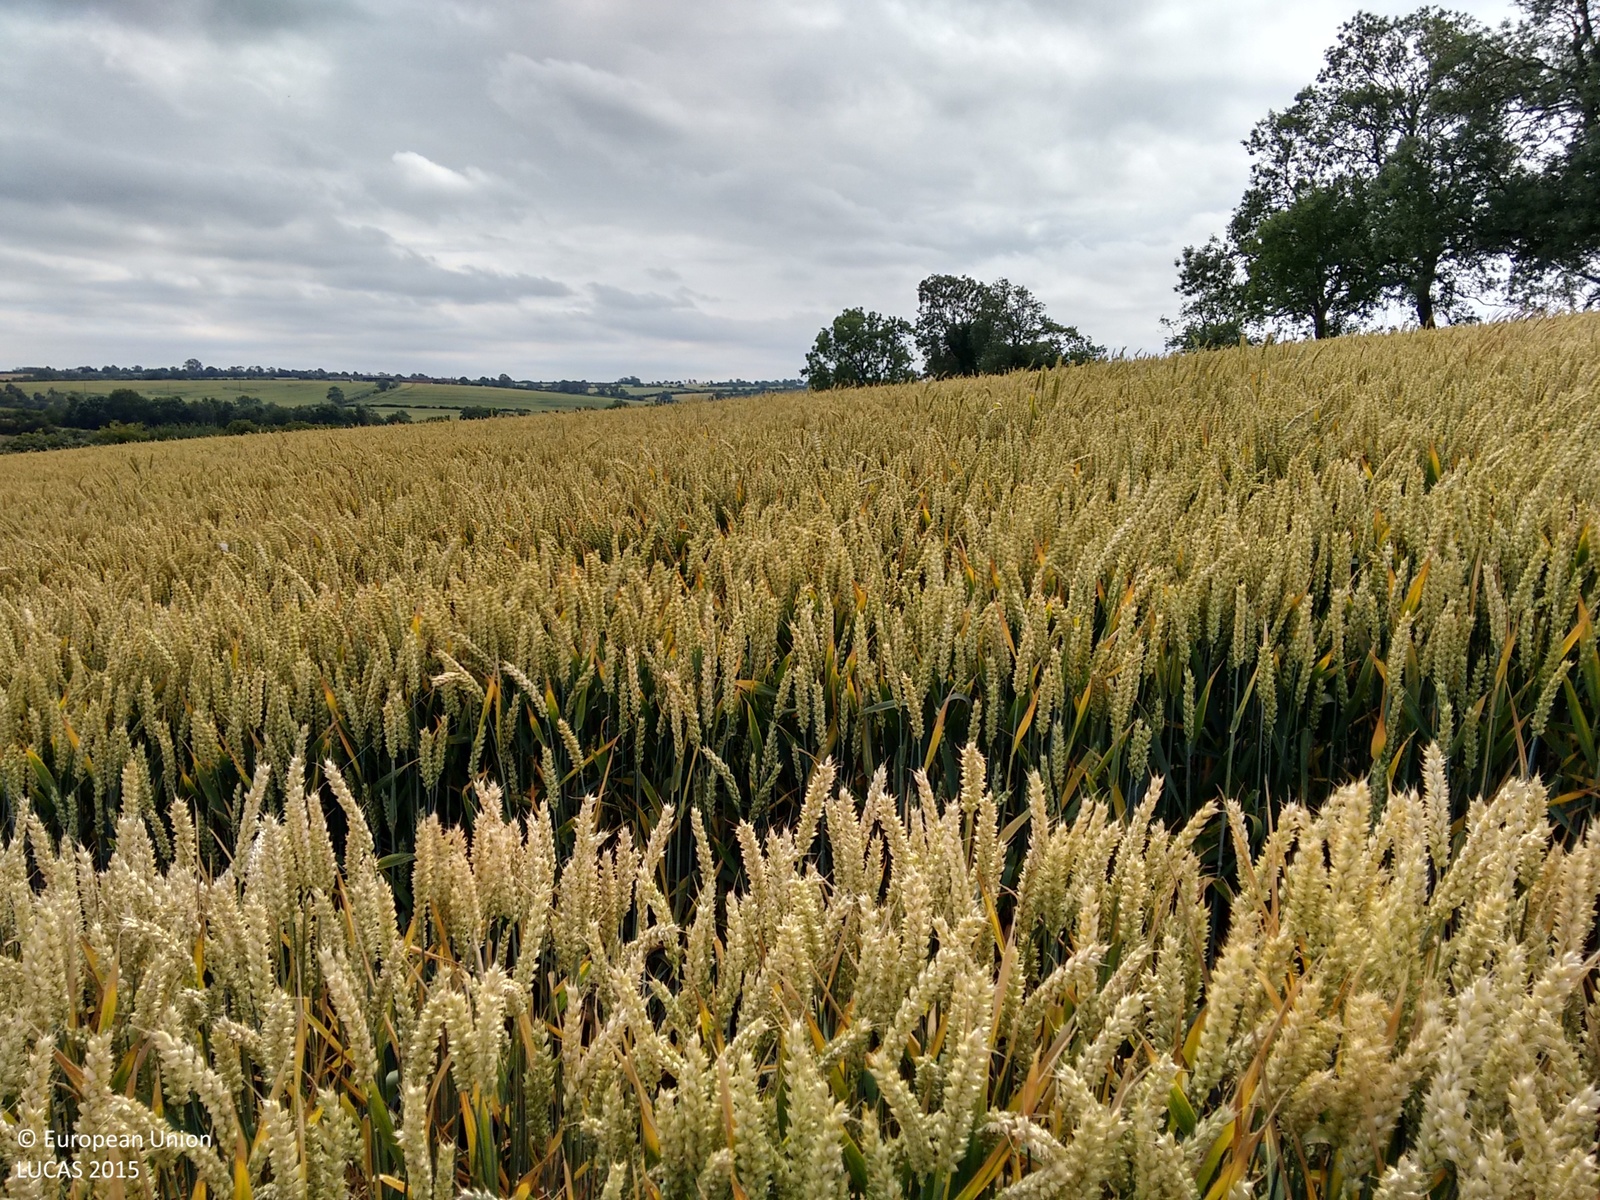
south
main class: Cropland
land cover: Common wheat
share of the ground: > 75 %
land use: Agriculture (excluding fallow land and kitchen gardens)
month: July
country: GB
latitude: 52.4584
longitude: -0.8593
